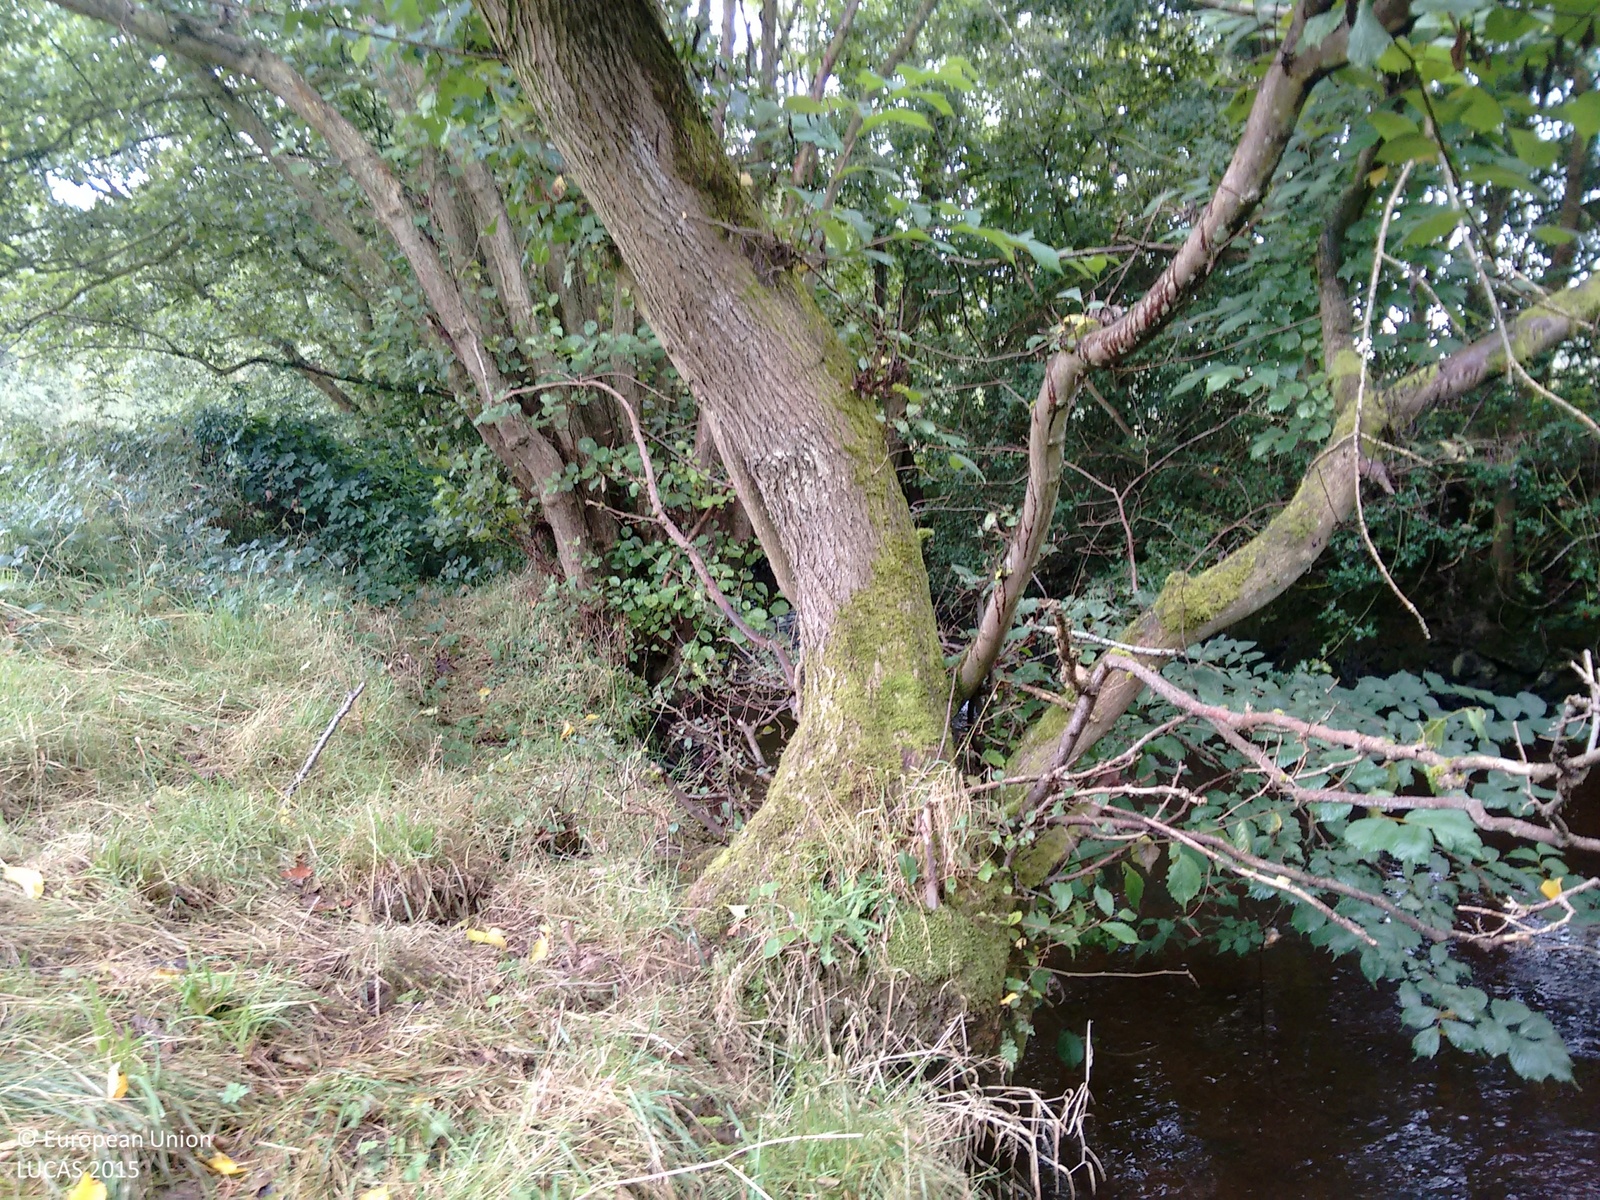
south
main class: Woodland
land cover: Other mixed woodland
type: mesophytic deciduous forest
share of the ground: > 75 %
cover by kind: broadleaved forest trees 60 %, coniferous forest trees 40 %
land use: Forestry
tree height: > 5 m
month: September
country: GB
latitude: 52.5425
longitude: -2.9164
